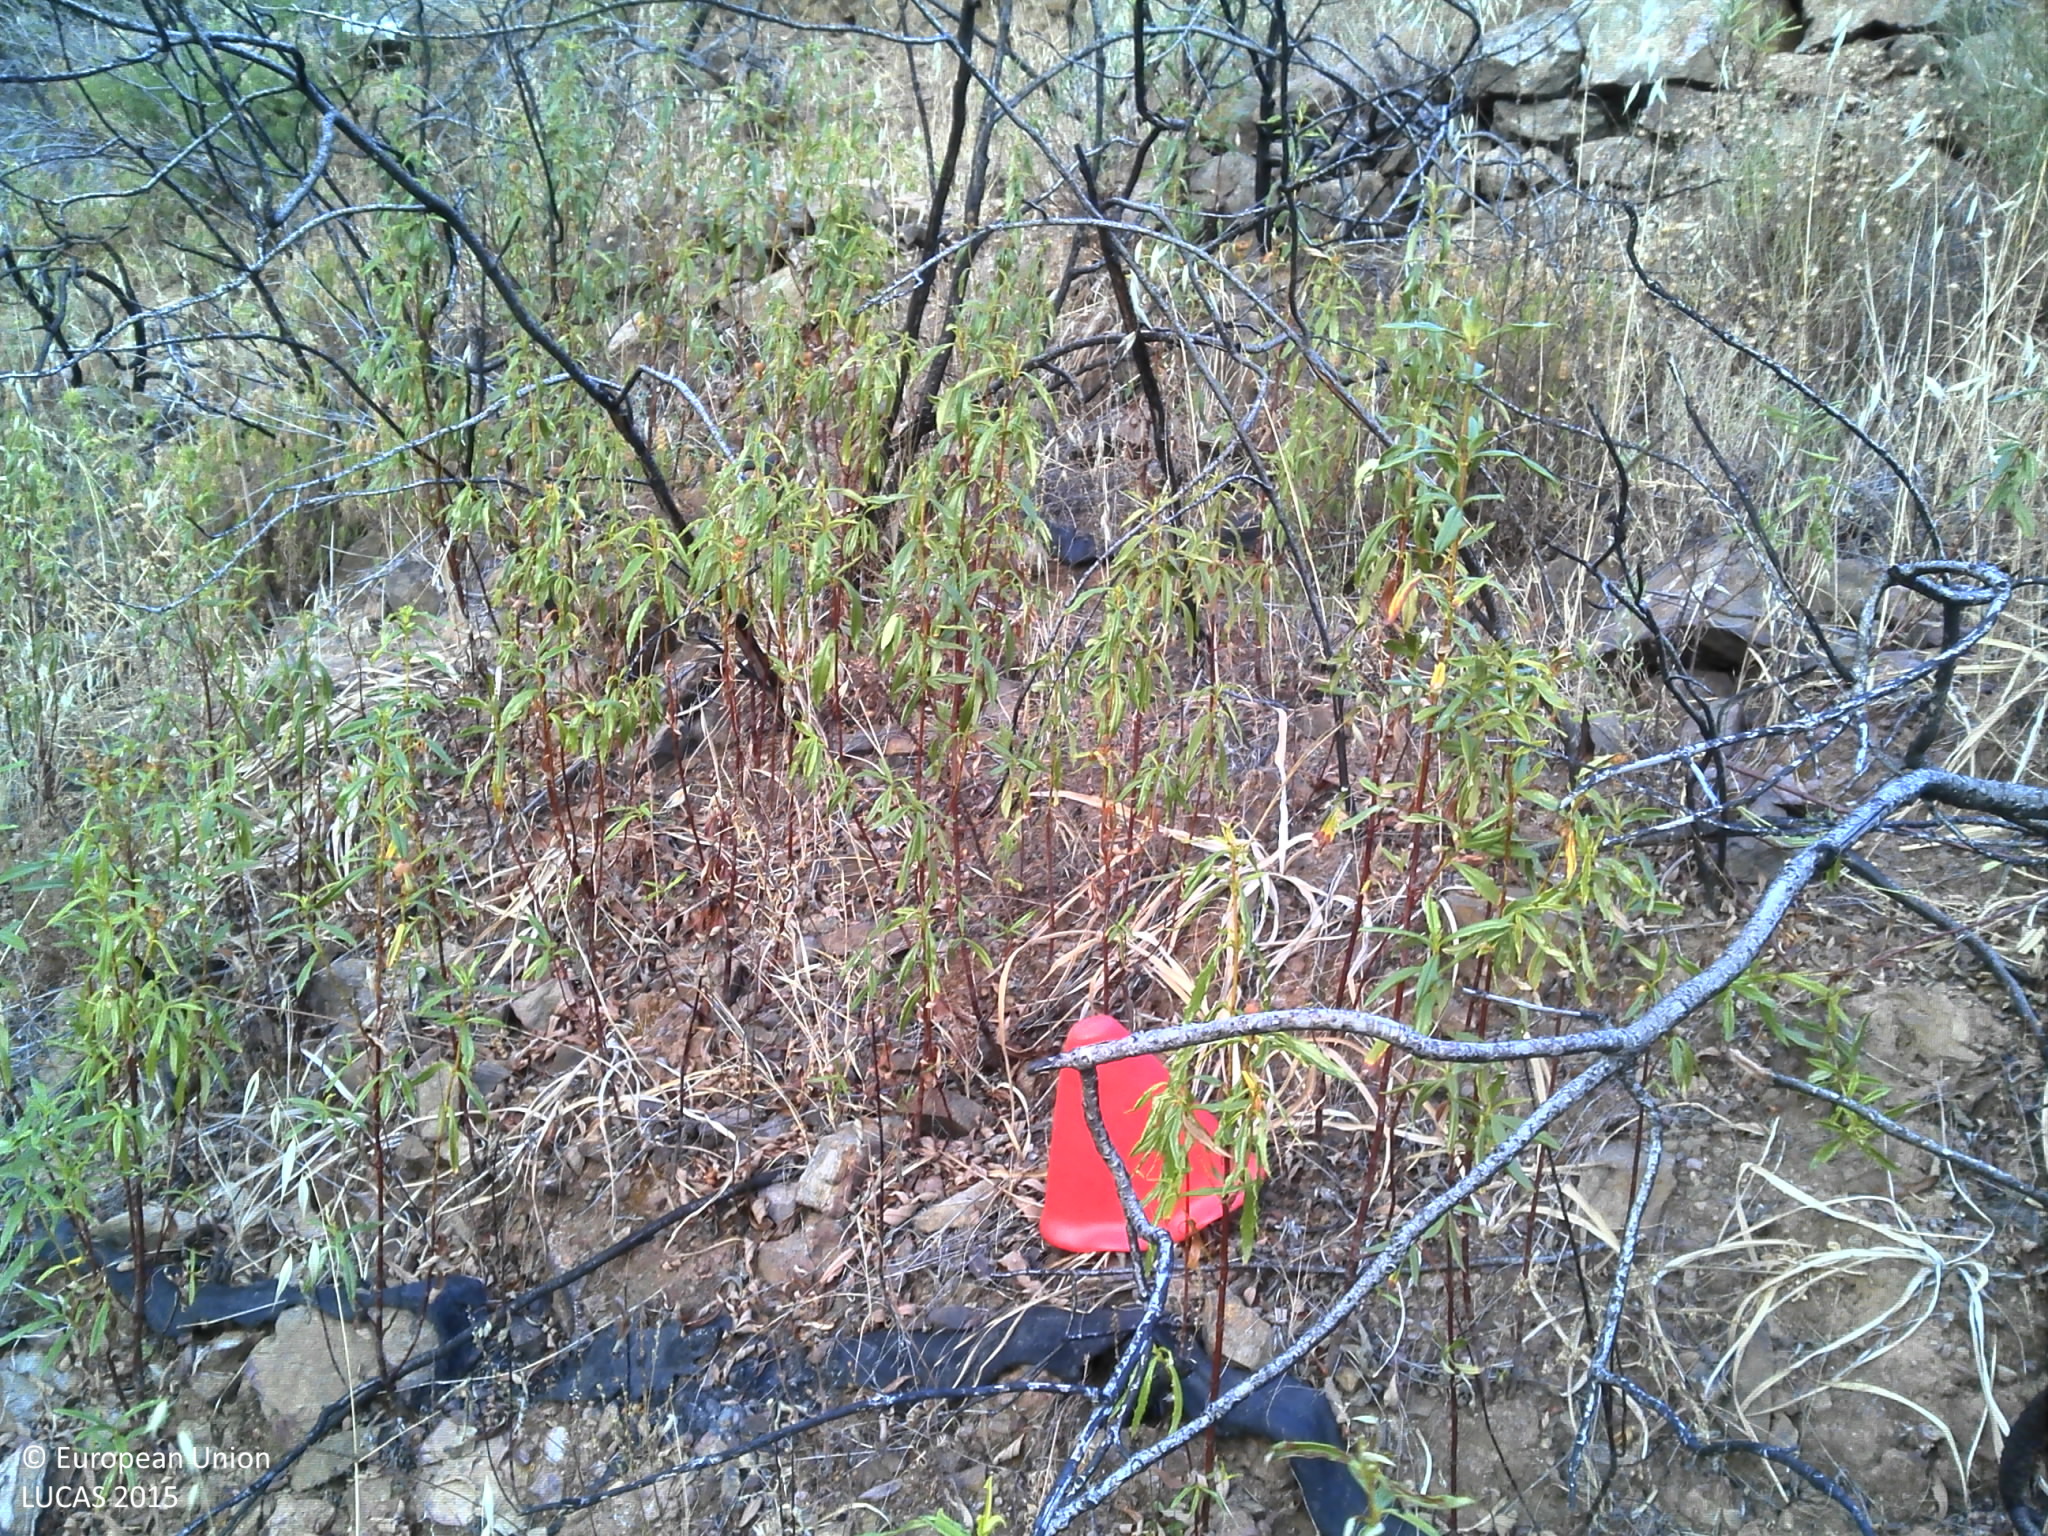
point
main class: Shrubland
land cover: Shrubland without tree cover
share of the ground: 50 - 75 %
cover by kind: shrubs 75 %, unconsolidated bare surface 15 %, herbaceous plants 10 %
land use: Abandoned areas
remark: Burnt area
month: June
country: PT
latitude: 37.1868
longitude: -7.6809
